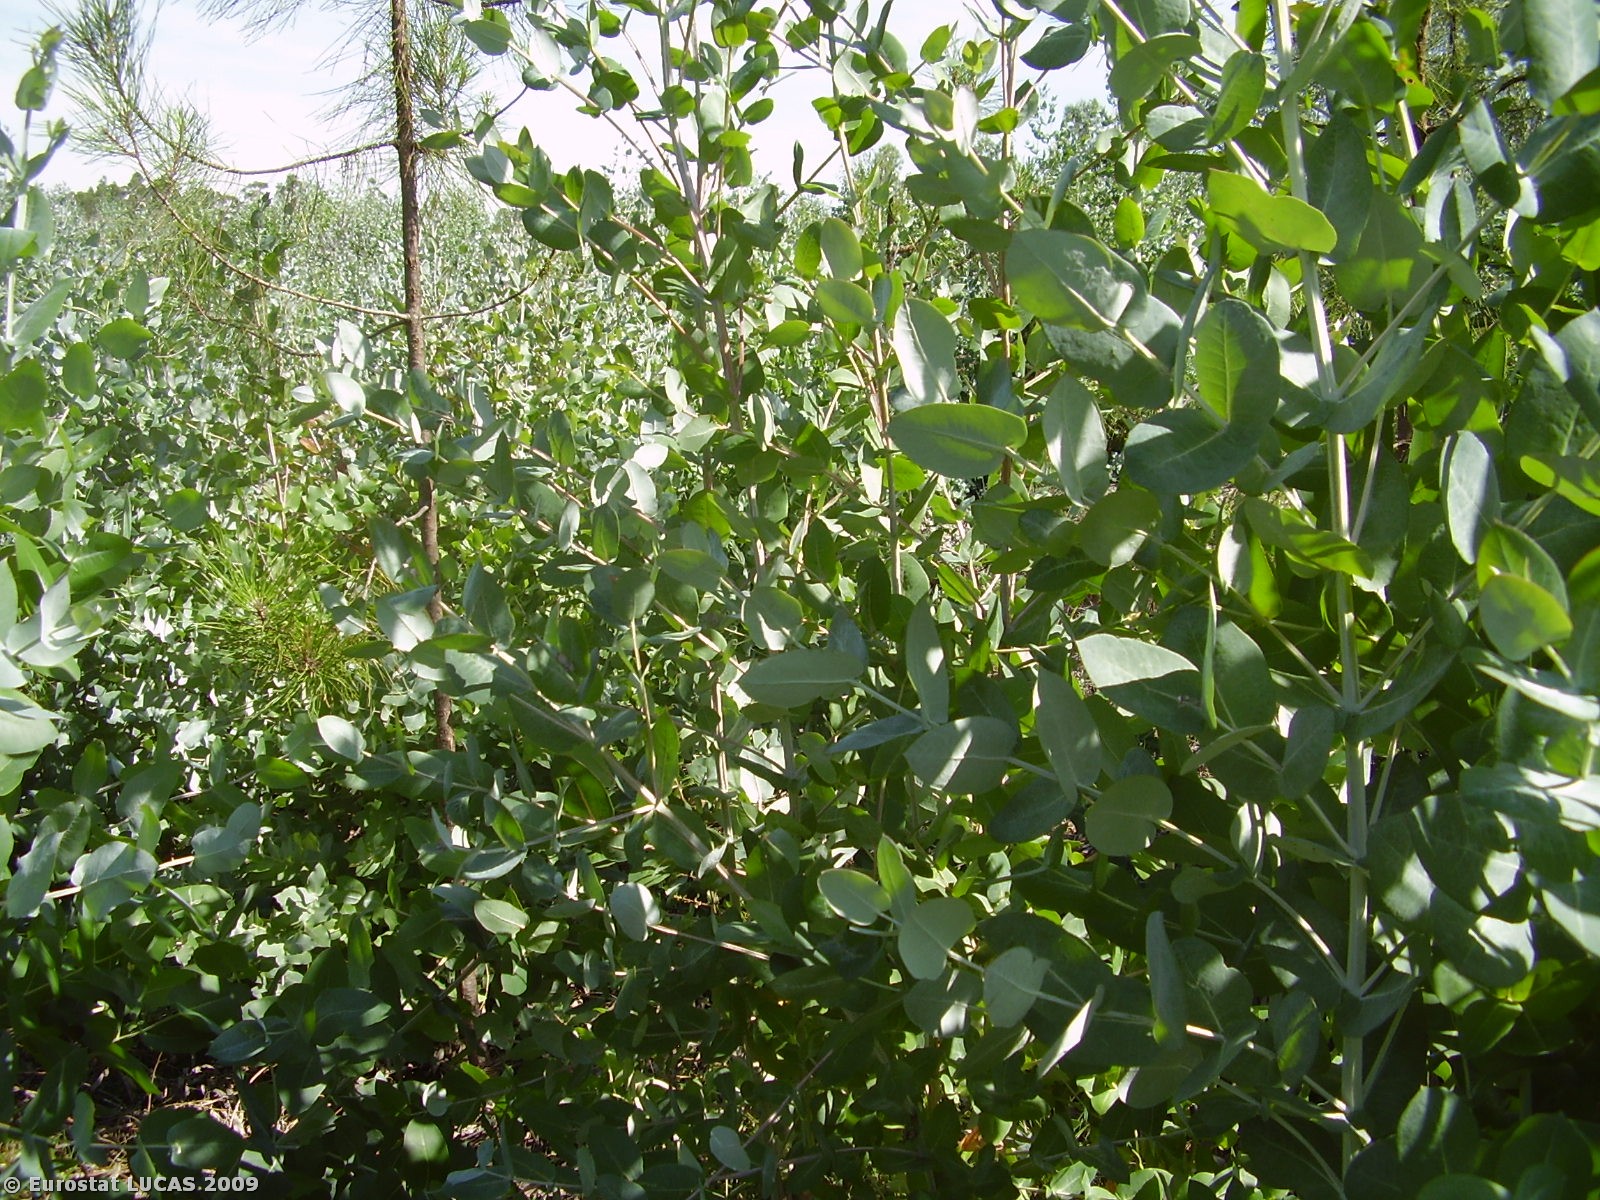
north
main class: Woodland
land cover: Broadleaved woodland
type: plantations and self-sown exotic forest
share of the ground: 50 - 75 %
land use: Forestry
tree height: > 5 m
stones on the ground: 10 - 25 %
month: July
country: PT
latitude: 39.5853
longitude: -8.1943
